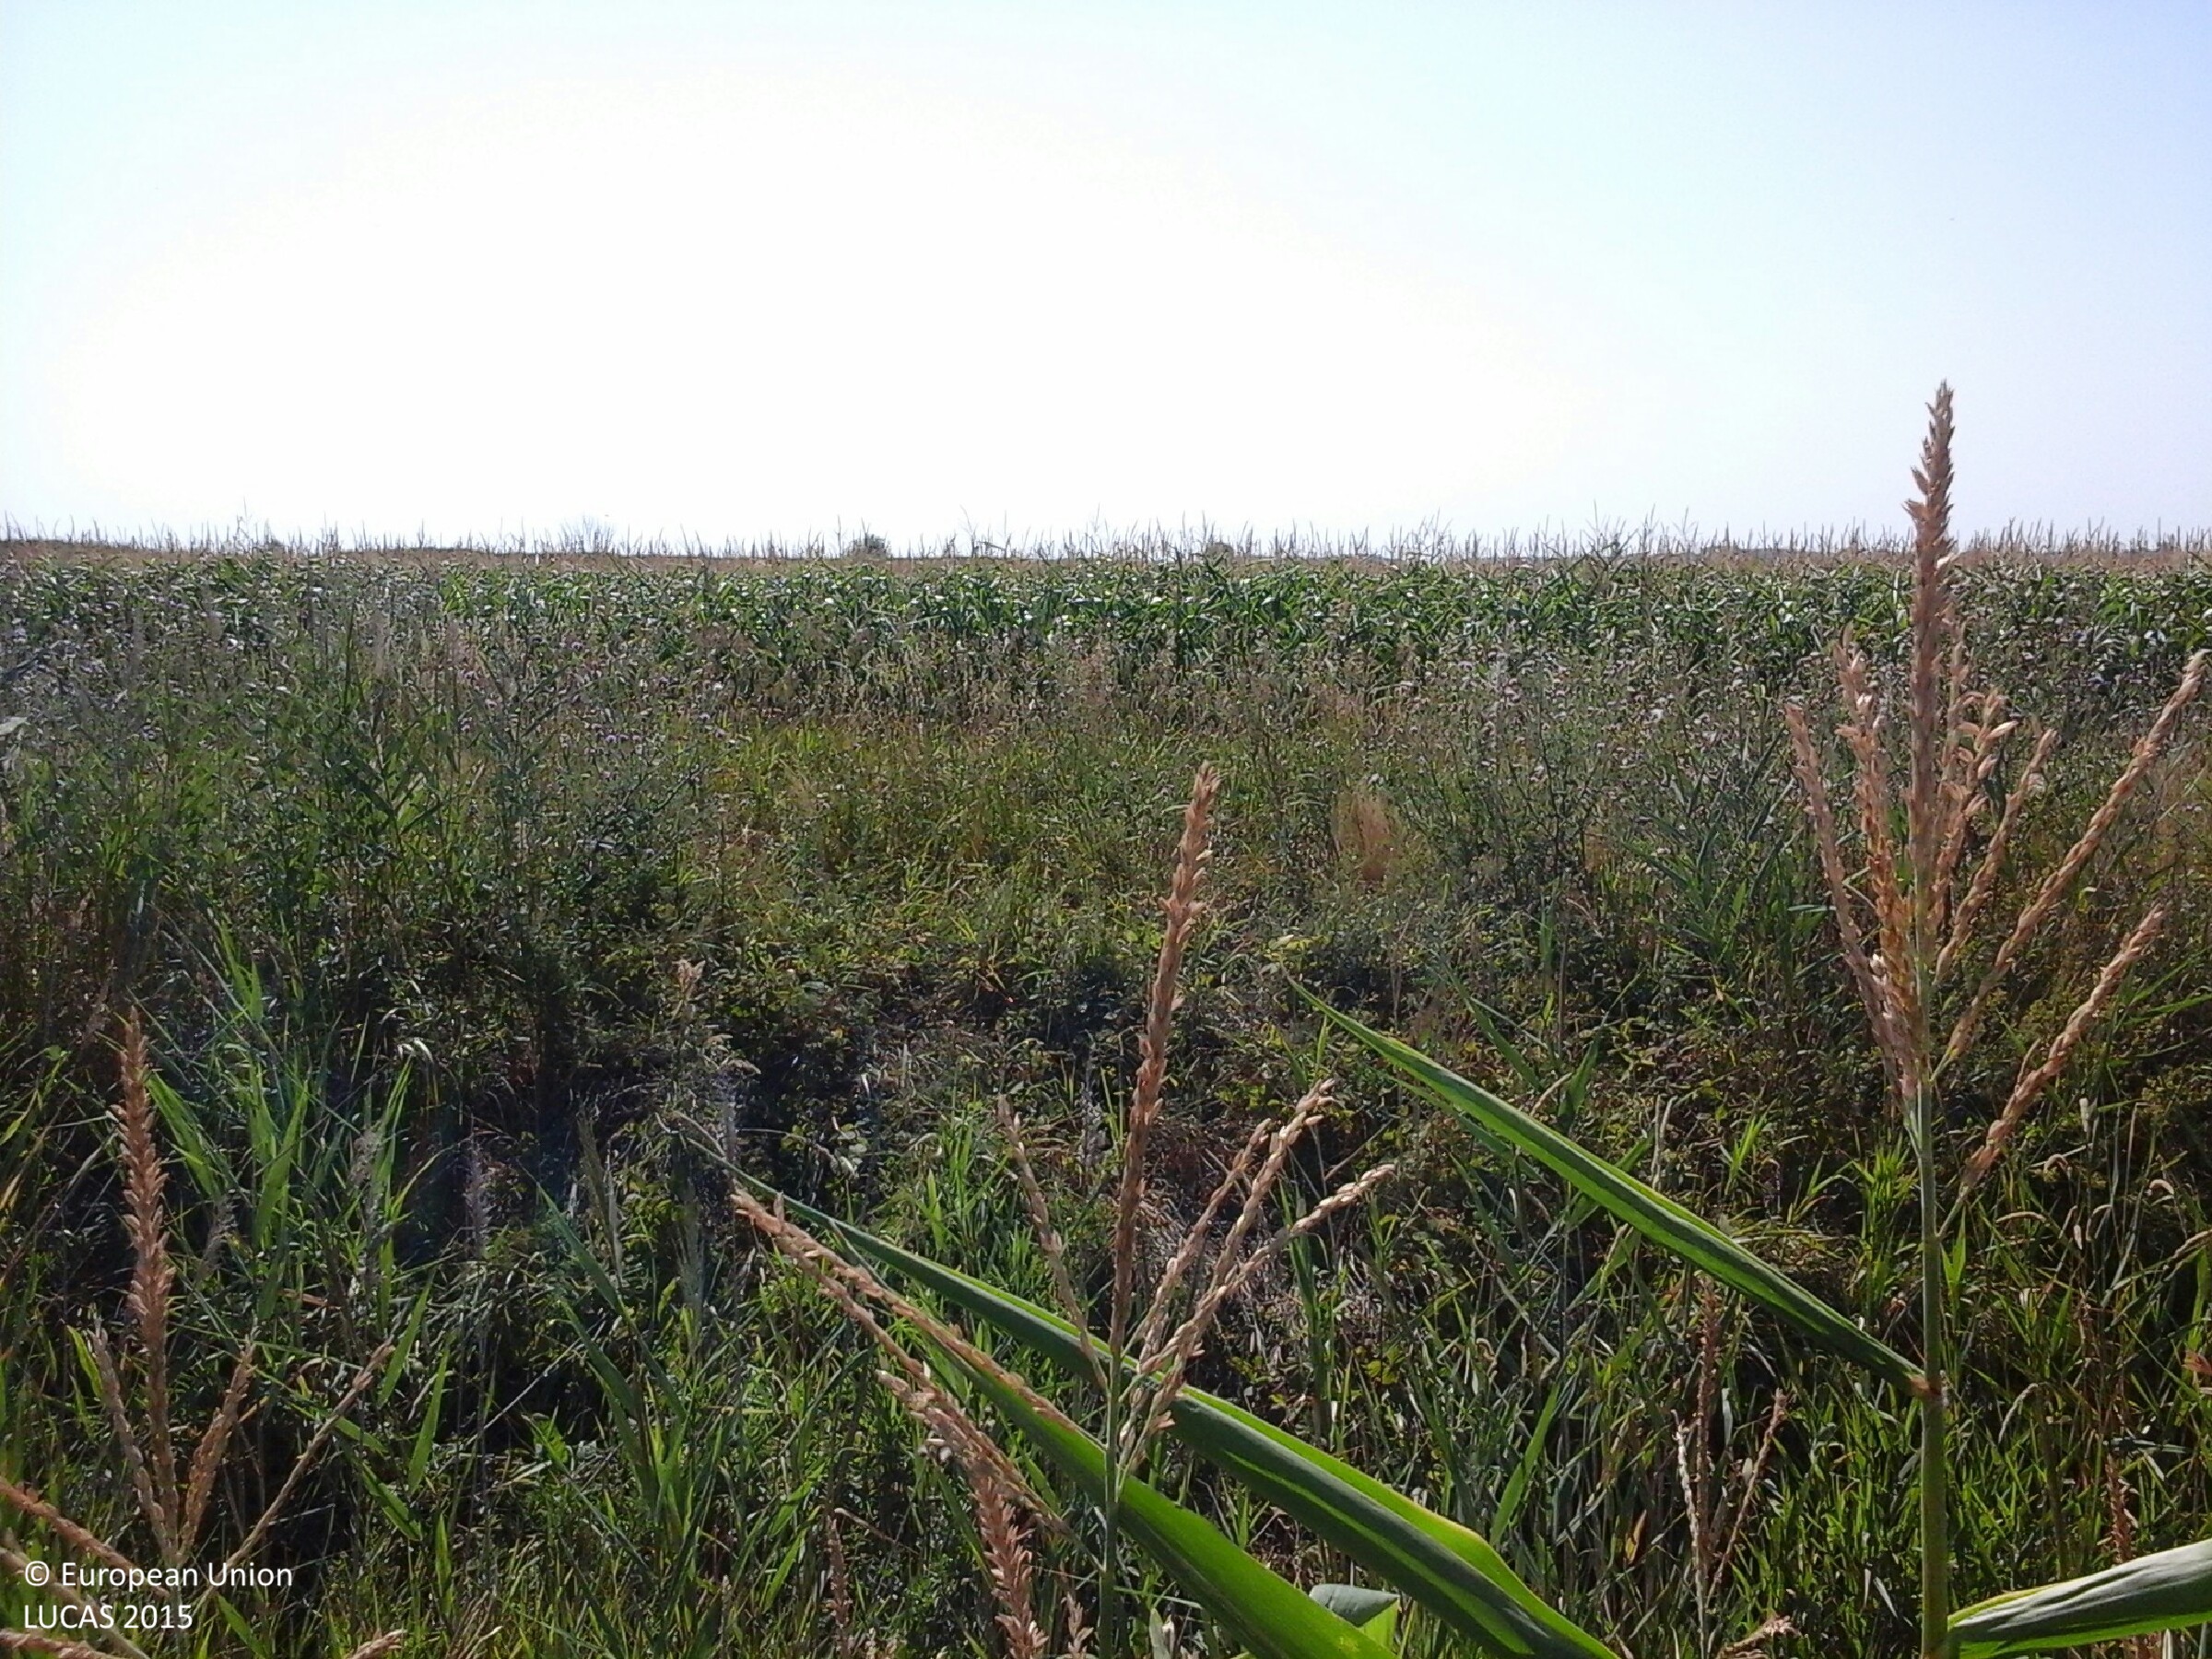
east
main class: Cropland
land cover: Maize
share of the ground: > 75 %
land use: Agriculture (excluding fallow land and kitchen gardens)
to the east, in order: Maize; Ditches and canals; Tracks; Grass margins; Ditches and canals; Maize; Sunflower; Tracks; Inland marshes; Inland fresh running water; Inland marshes; Common wheat
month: July
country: HU
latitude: 47.6422
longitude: 20.5614
